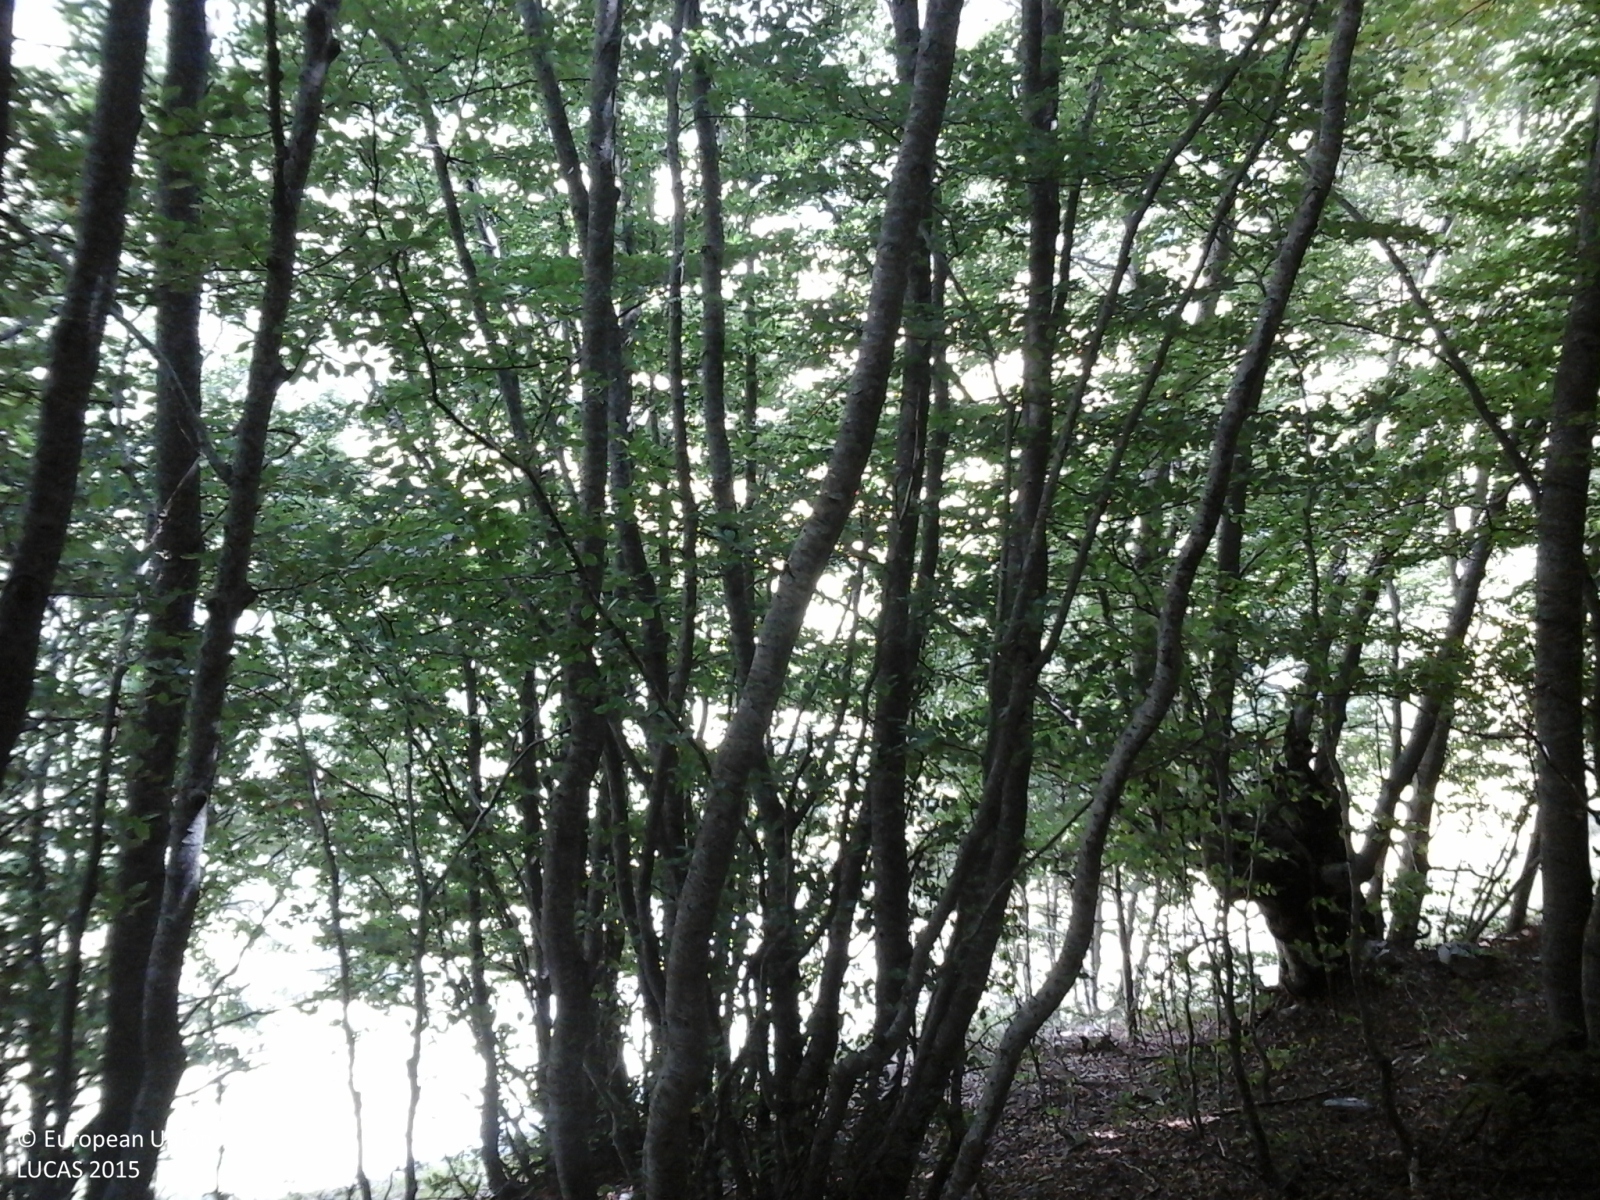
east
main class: Woodland
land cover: Broadleaved woodland
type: mountainous beech forest
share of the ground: > 75 %
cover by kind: broadleaved forest trees 100 %
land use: Forestry
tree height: > 5 m
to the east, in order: Broadleaved woodland; Grassland with sparse tree/shrub cover; Grassland without tree/shrub cover; Dry pulses
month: August
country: IT
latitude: 42.8562
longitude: 13.2093
